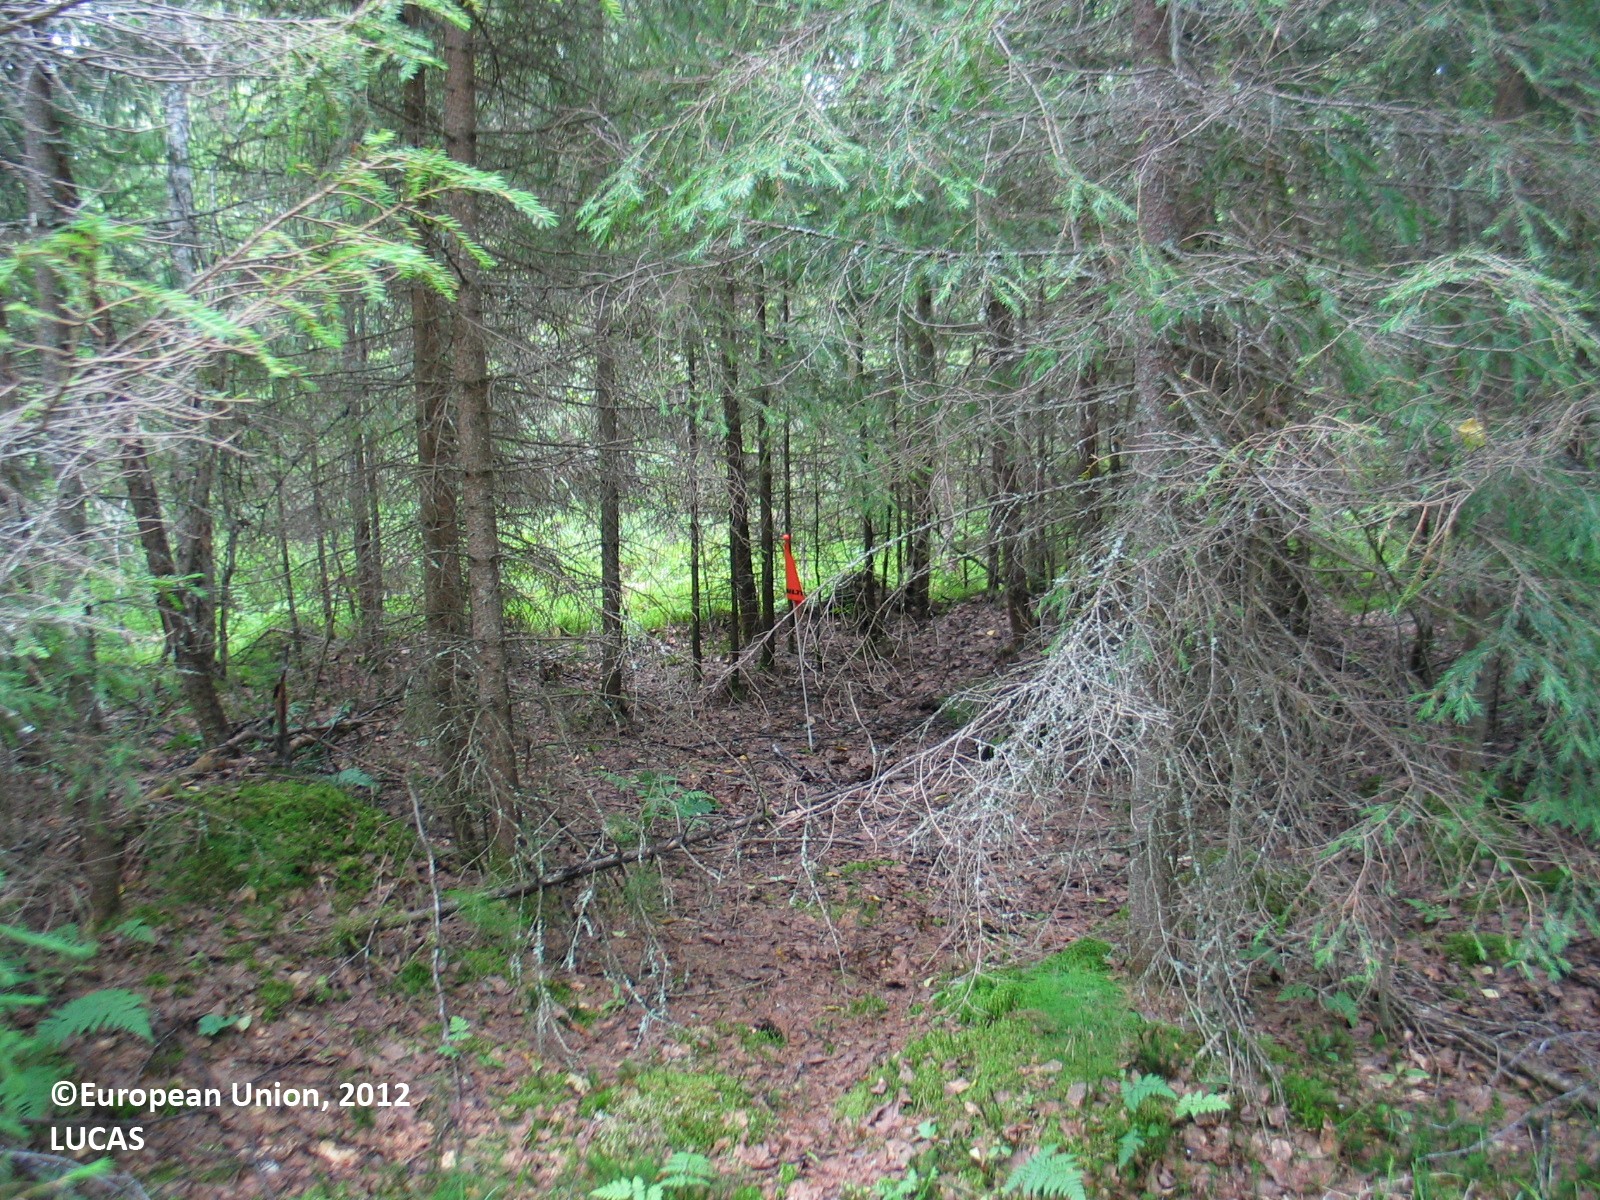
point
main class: Woodland
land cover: Other mixed woodland
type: mire and swamp forests
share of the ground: 50 - 75 %
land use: Forestry
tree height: > 5 m
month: July
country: FI
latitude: 64.5812
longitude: 26.3332
